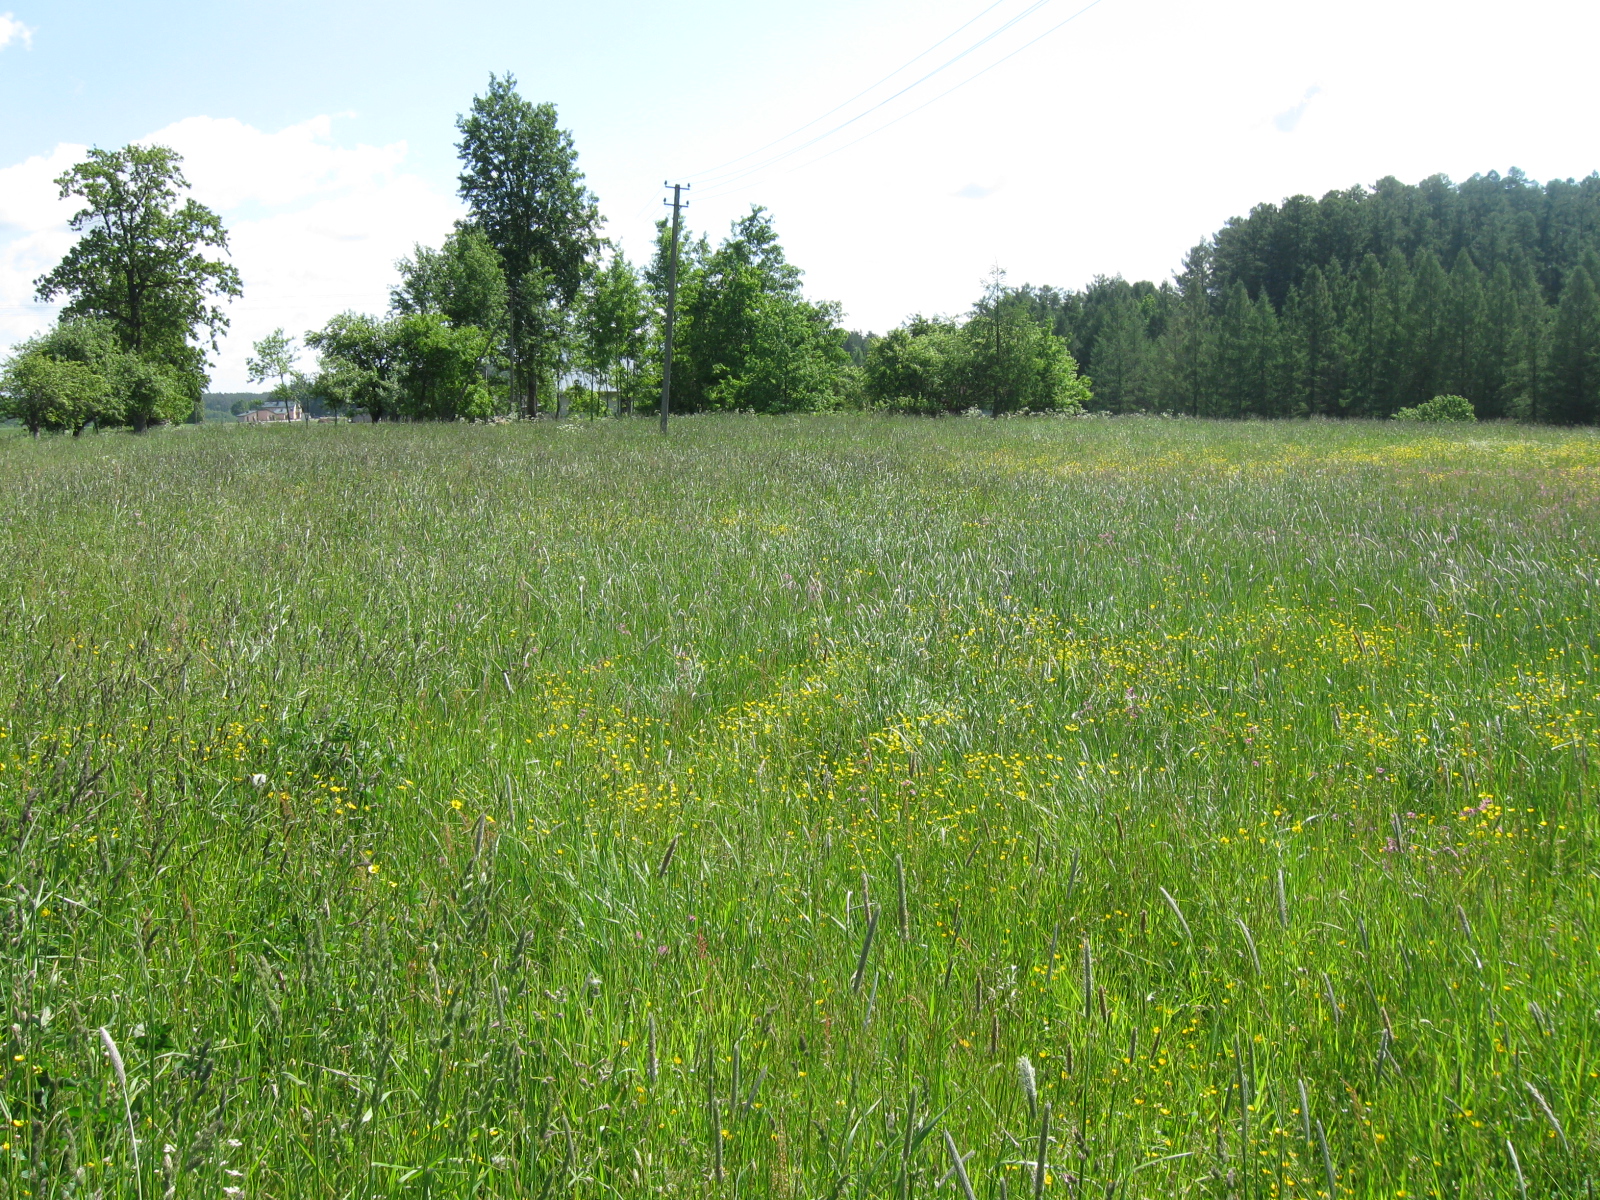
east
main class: Grassland
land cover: Grassland without tree/shrub cover
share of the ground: > 75 %
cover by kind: herbaceous plants 100 %
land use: Agriculture (excluding fallow land and kitchen gardens)
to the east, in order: Grassland without tree/shrub cover; Electric lines; Grassland without tree/shrub cover; Broadleaved woodland; Grassland without tree/shrub cover; Artificial constructions in urban areas; Common wheat; Grassland without tree/shrub cover
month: June
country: LT
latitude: 54.5706
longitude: 23.8713
